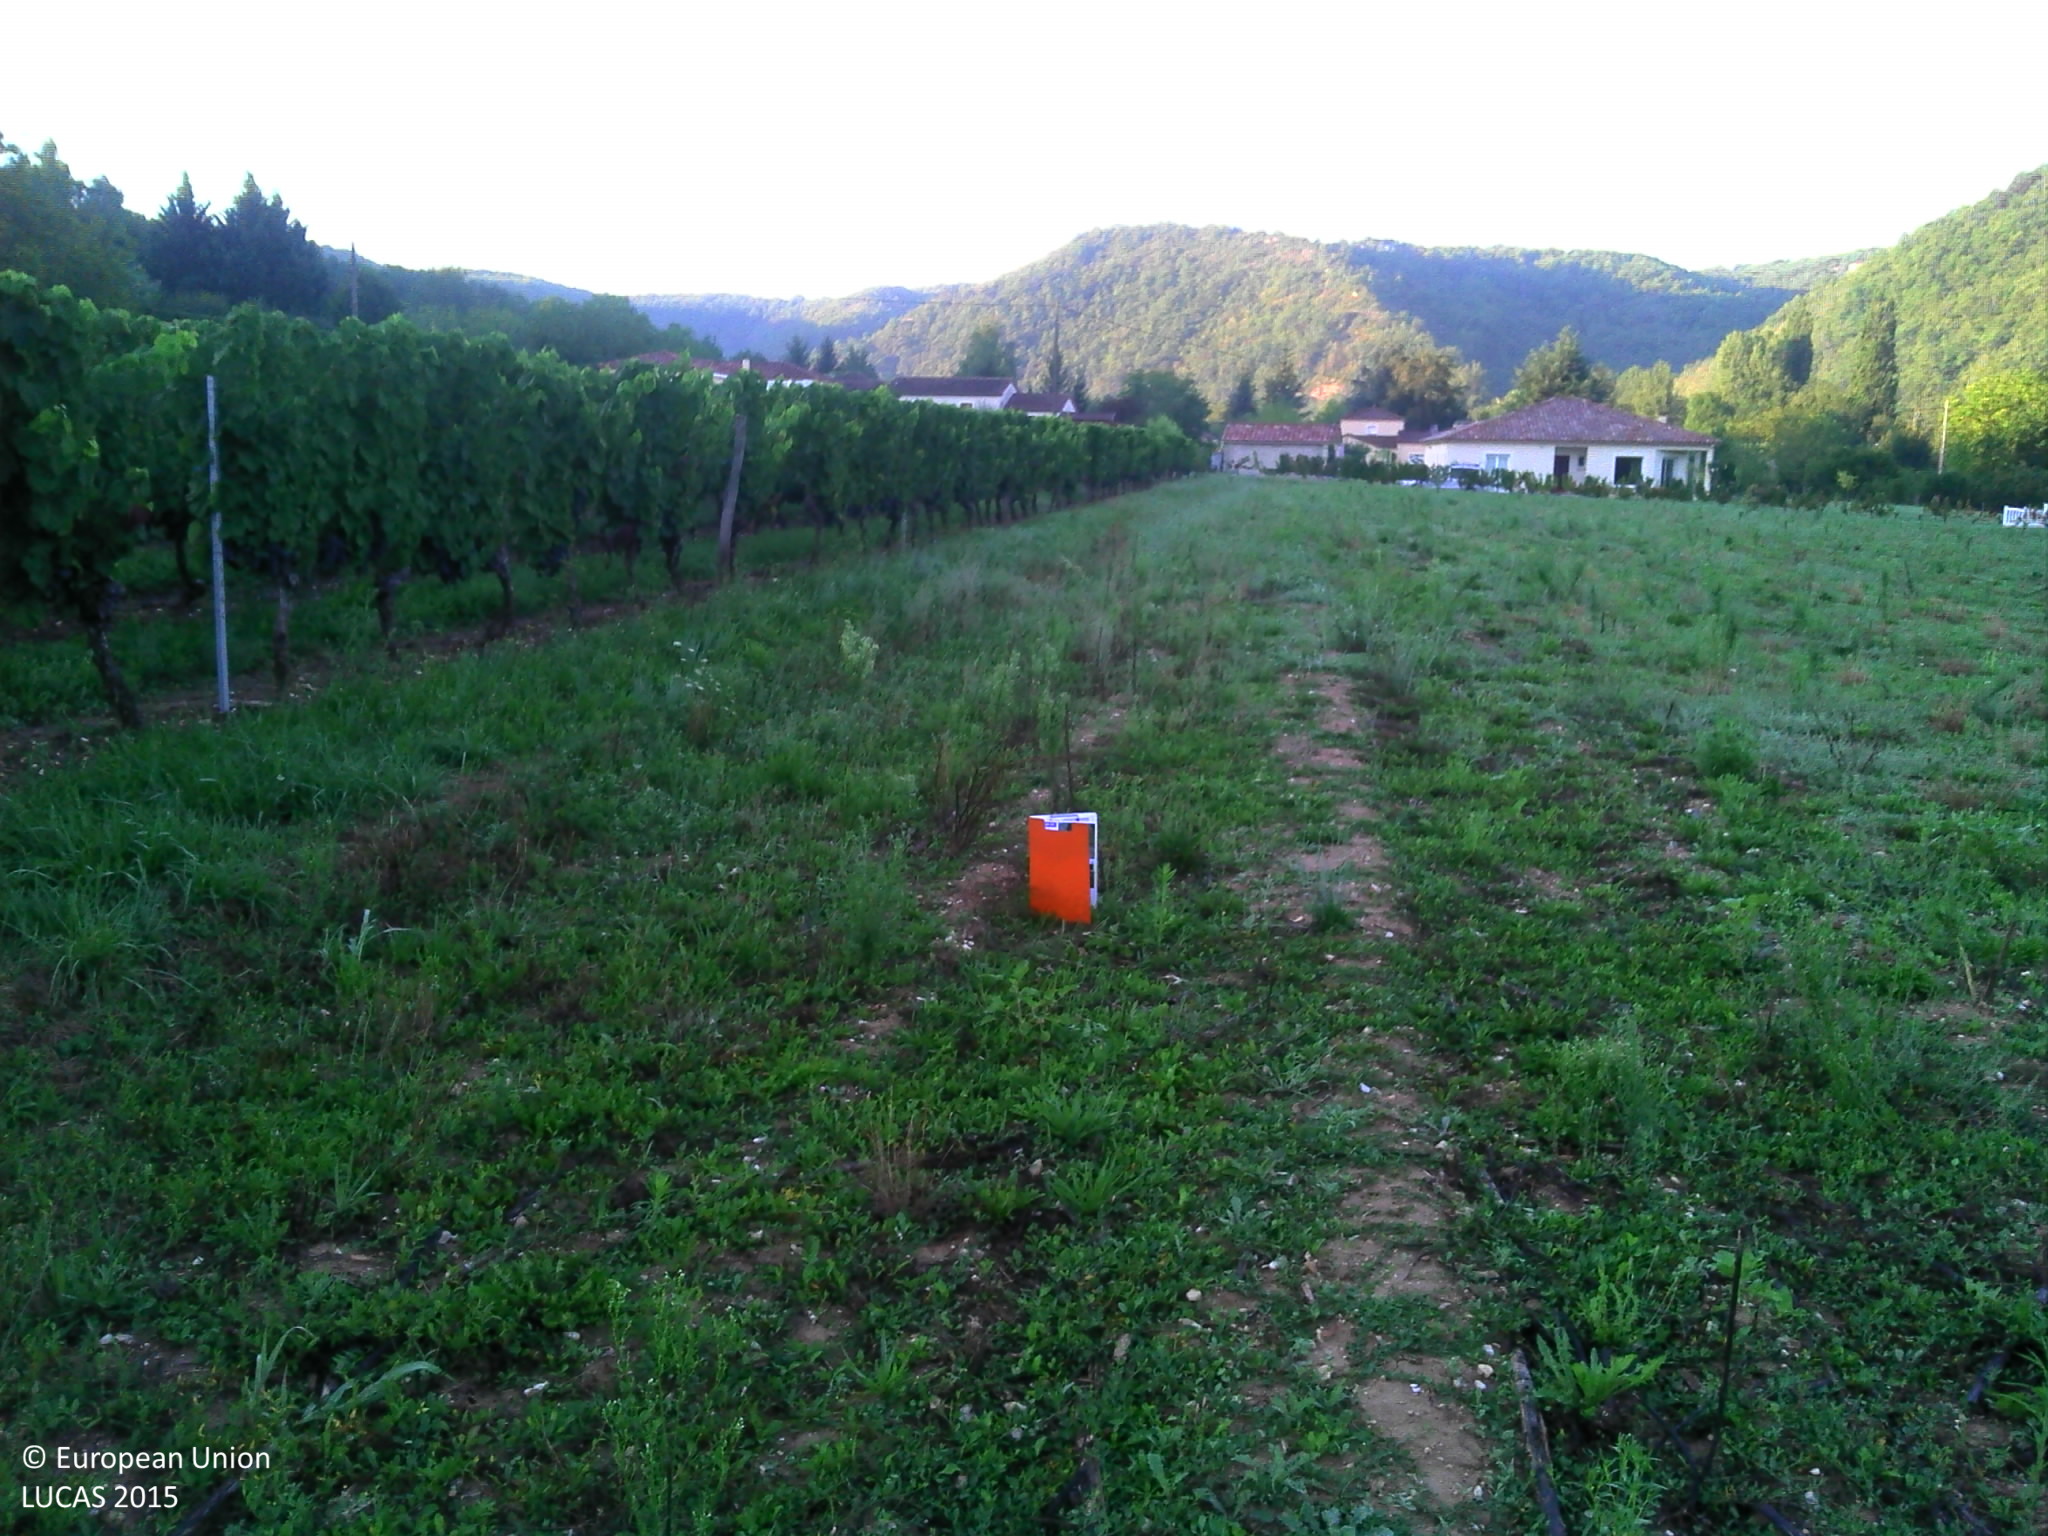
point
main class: Grassland
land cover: Grassland without tree/shrub cover
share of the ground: > 75 %
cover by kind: herbaceous plants 100 %
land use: Agriculture (excluding fallow land and kitchen gardens)
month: August
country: FR
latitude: 44.4729
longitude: 1.2854
